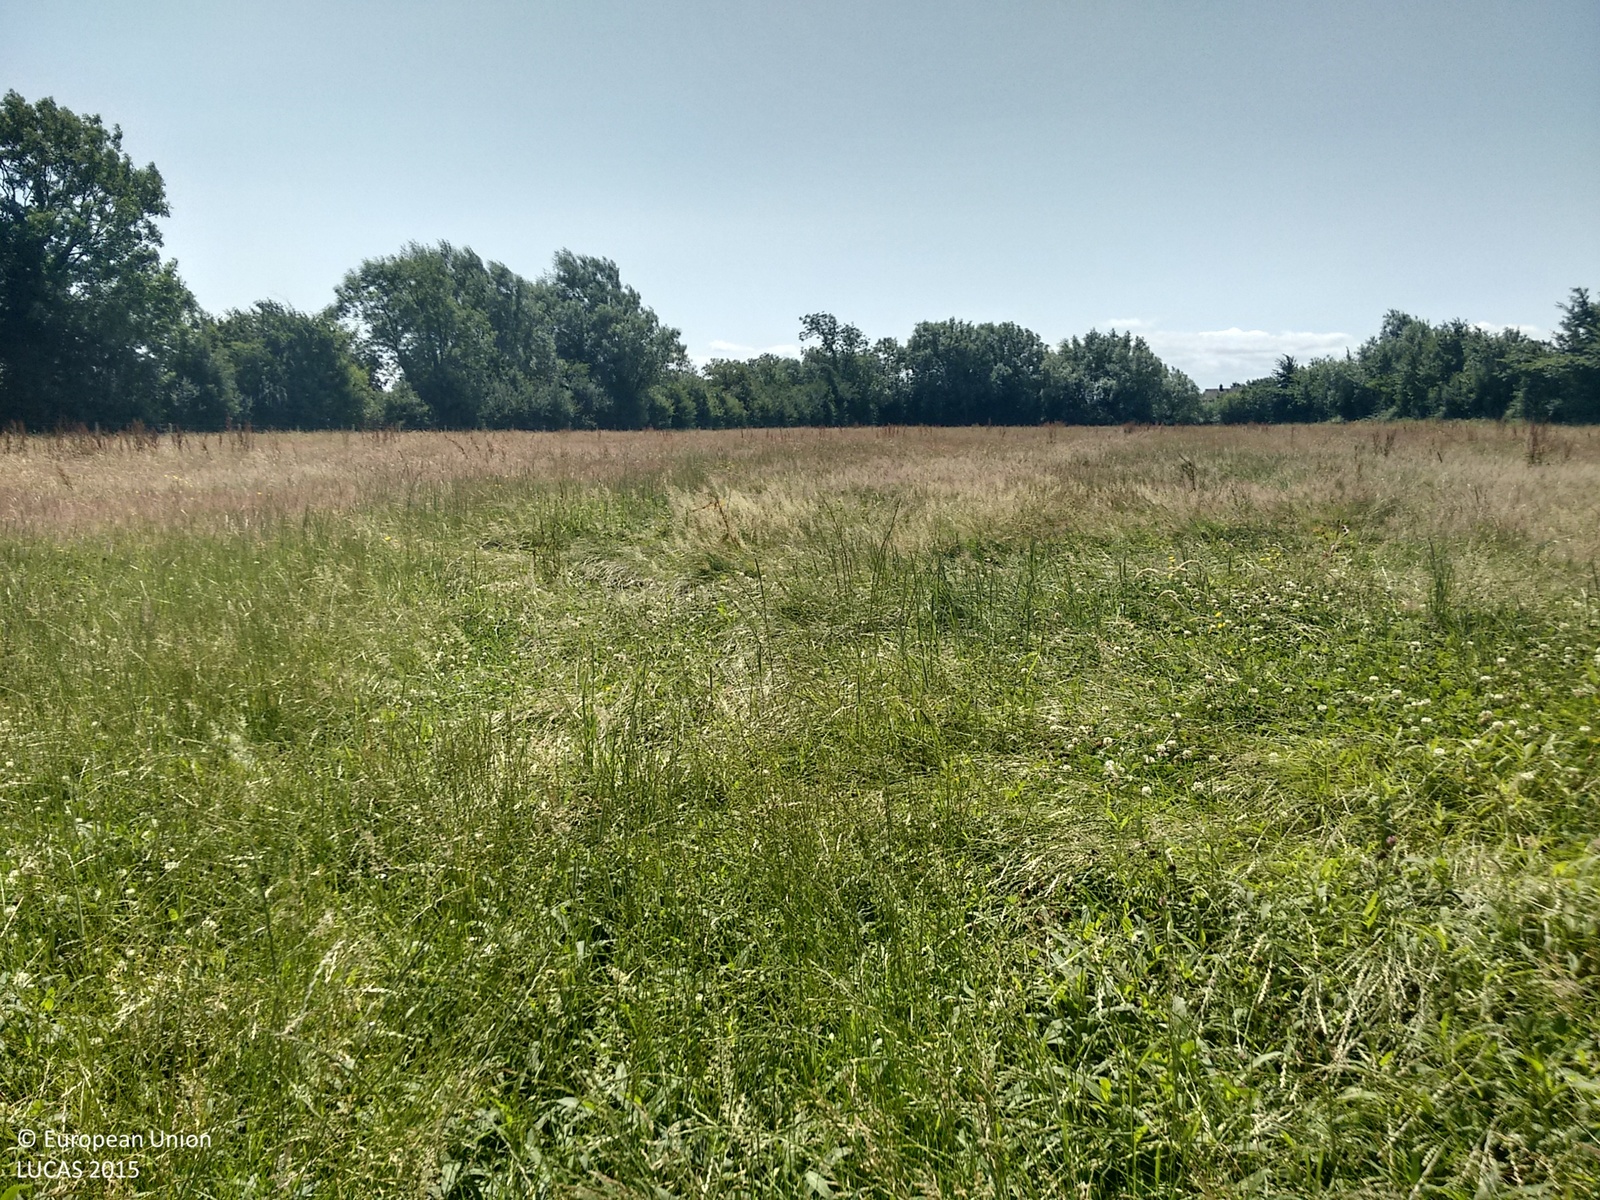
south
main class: Grassland
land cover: Grassland without tree/shrub cover
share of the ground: > 75 %
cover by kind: herbaceous plants 100 %
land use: Agriculture (excluding fallow land and kitchen gardens)
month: July
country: GB
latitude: 51.2658
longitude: -2.9295
